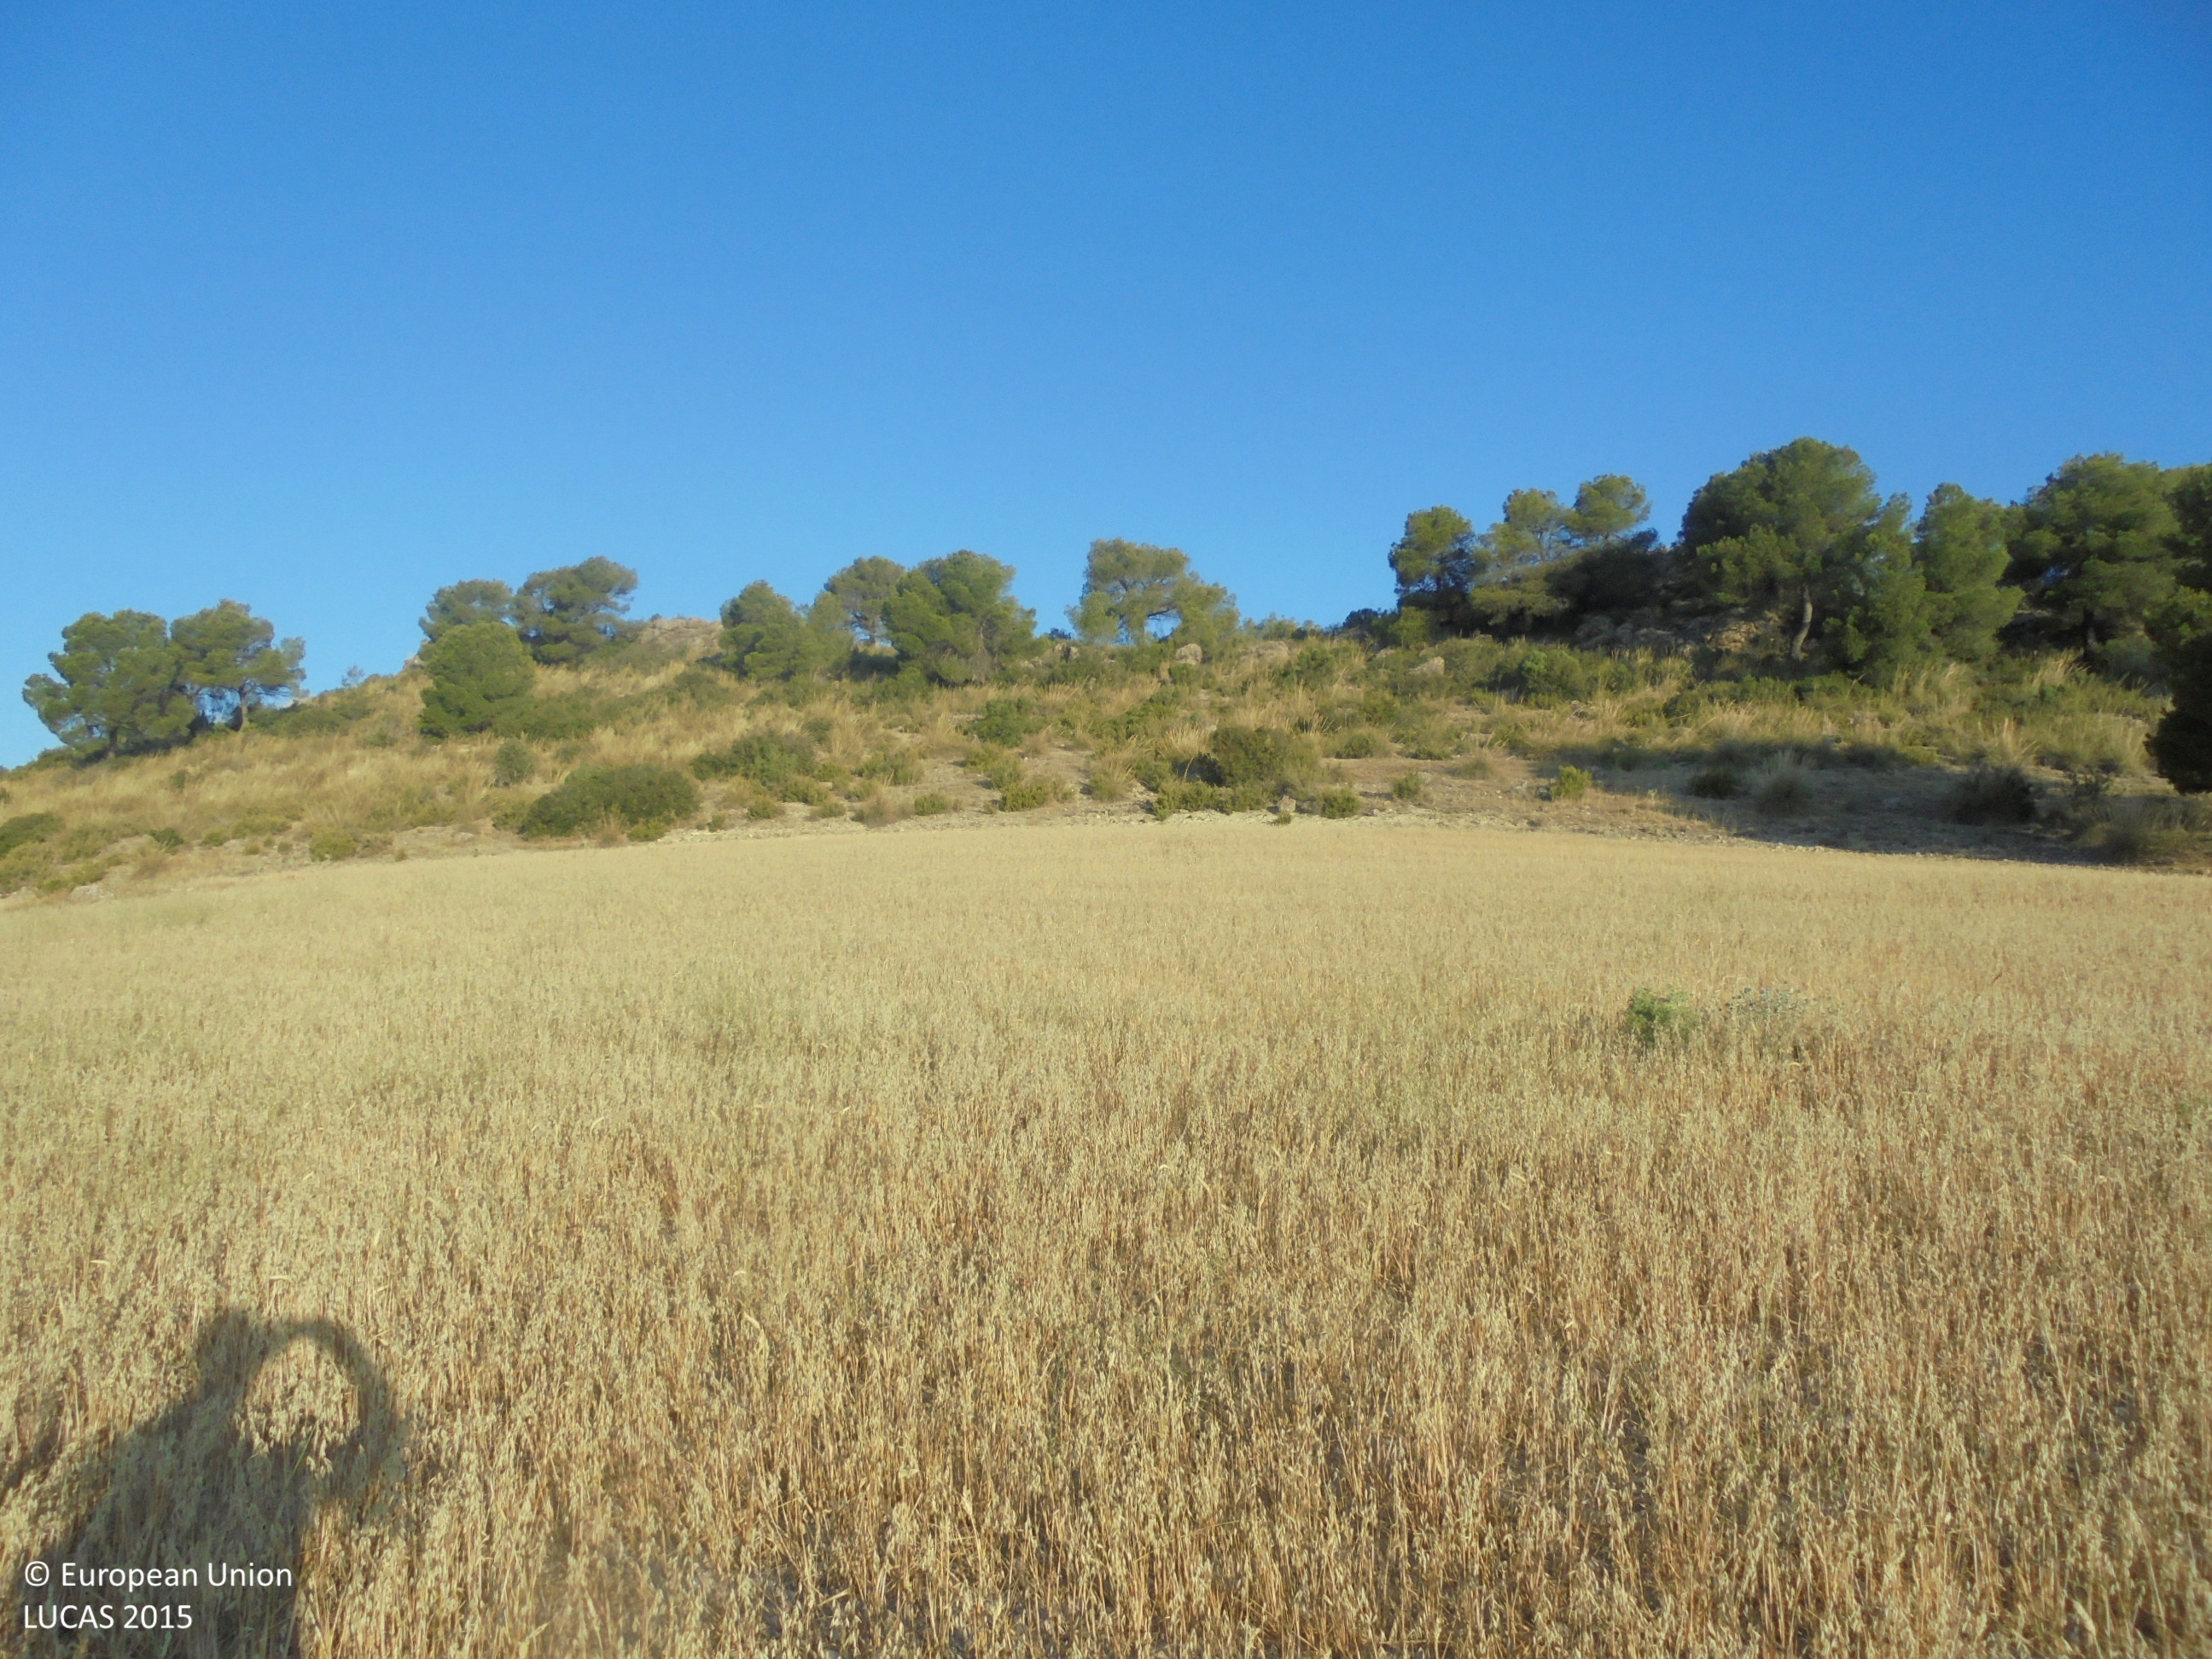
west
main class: Cropland
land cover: Oats
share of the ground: 25 - 50 %
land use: Agriculture (excluding fallow land and kitchen gardens)
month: July
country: ES
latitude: 38.7332
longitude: -1.6258
